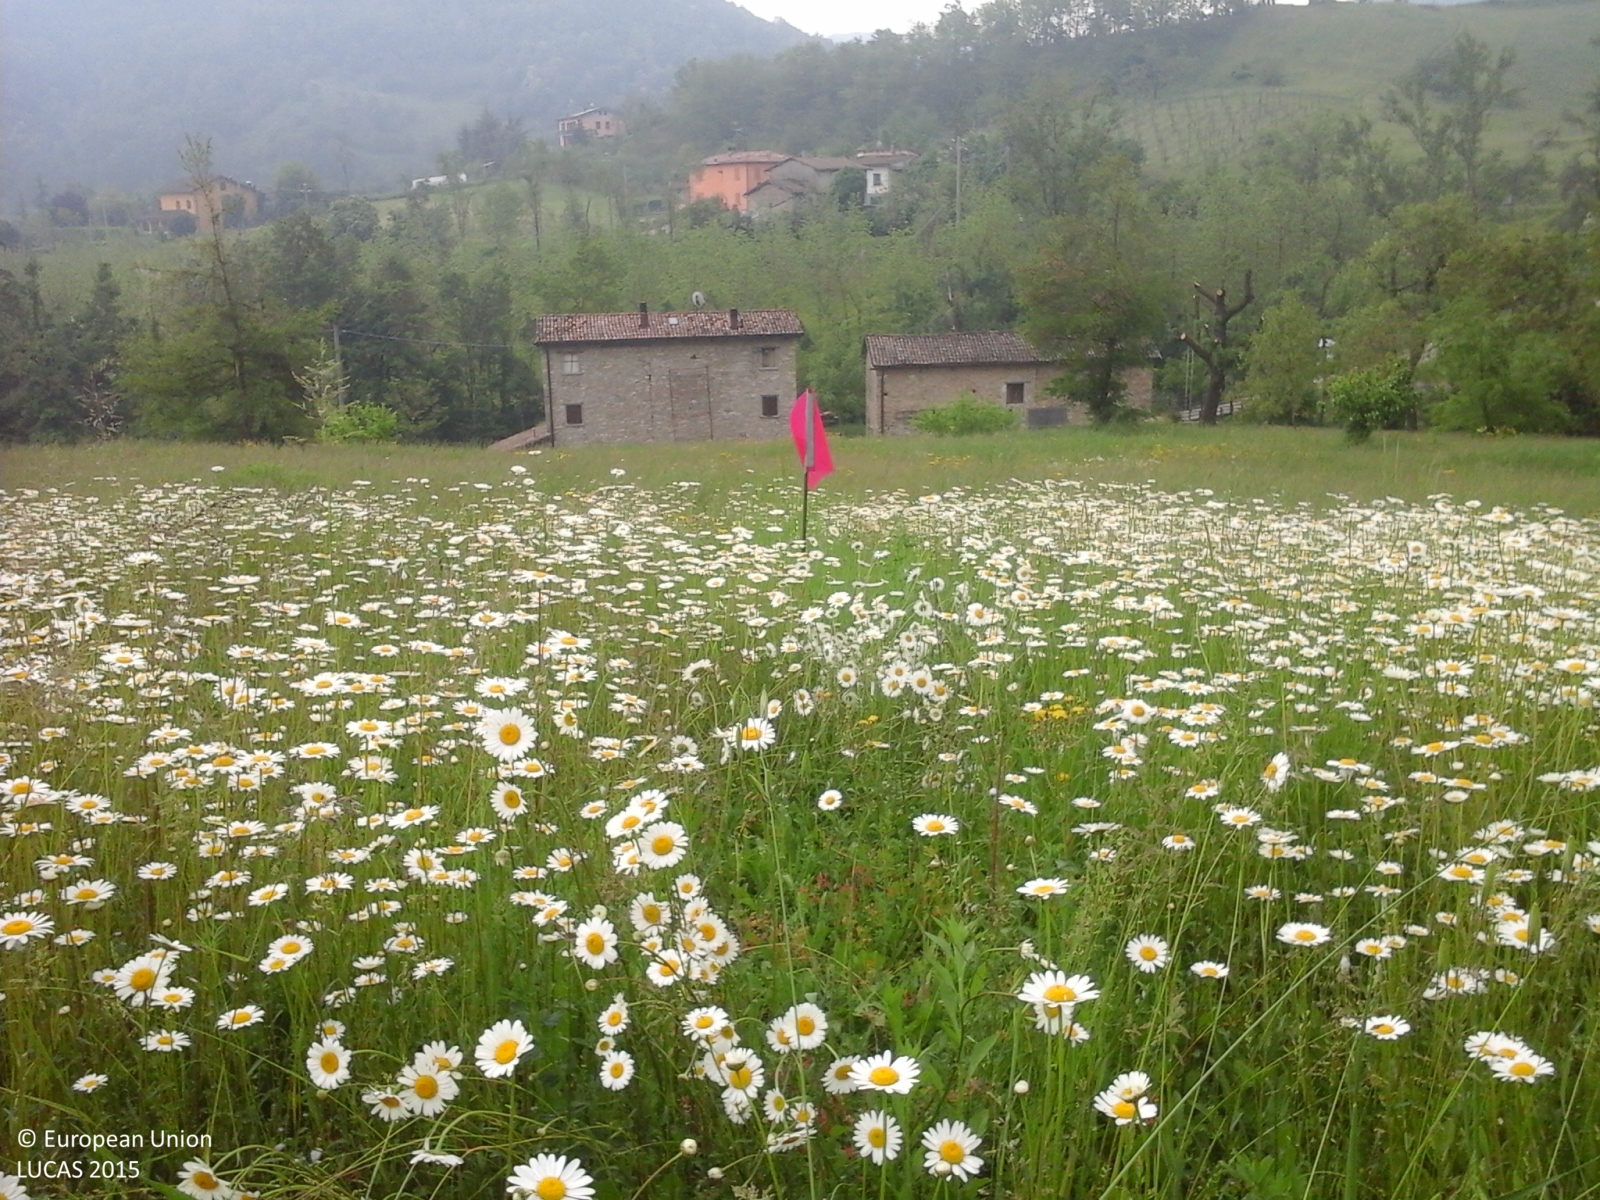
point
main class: Cropland
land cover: Lucerne
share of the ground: 50 - 75 %
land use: Agriculture (excluding fallow land and kitchen gardens)
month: May
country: IT
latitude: 44.3812
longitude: 11.0645
